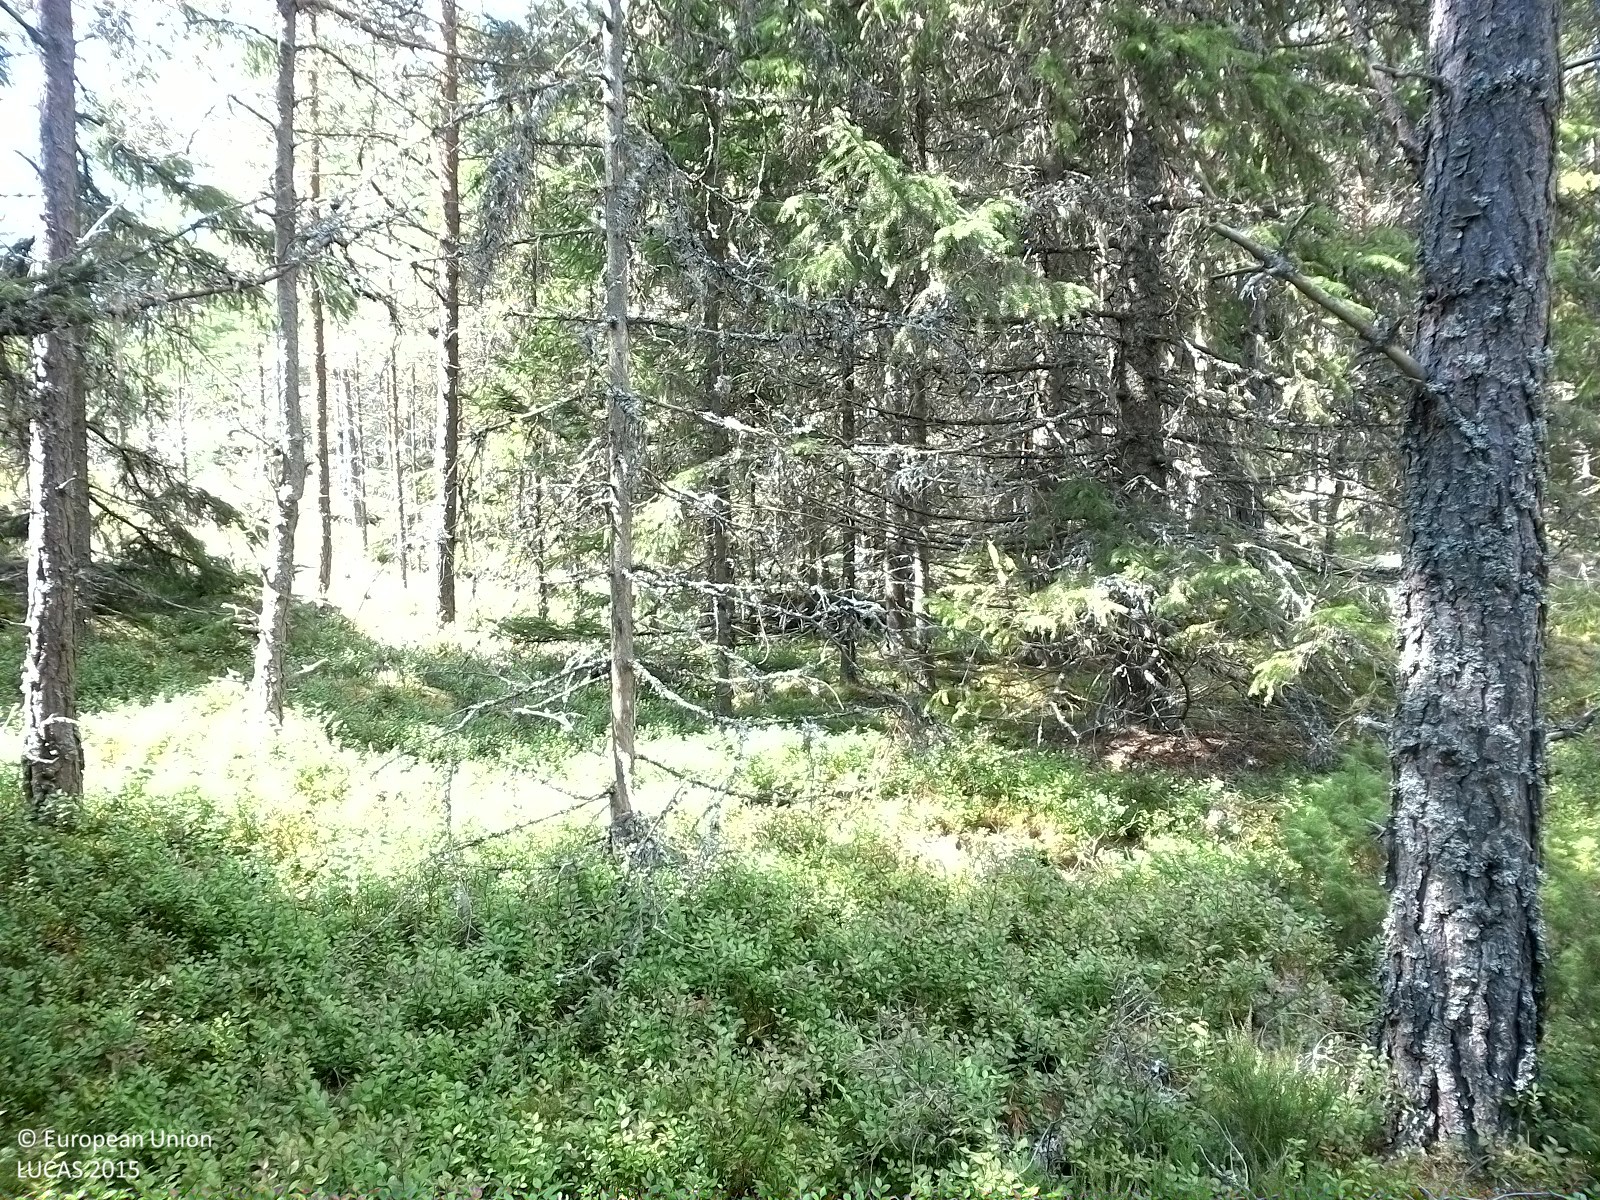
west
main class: Woodland
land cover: Pine dominated coniferous woodland
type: boreal forest
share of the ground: 25 - 50 %
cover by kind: shrubs 50 %, coniferous forest trees 30 %, broadleaved forest trees 10 %, herbaceous plants 10 %
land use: Forestry
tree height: > 5 m
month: August
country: SE
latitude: 58.9049
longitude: 15.3917
